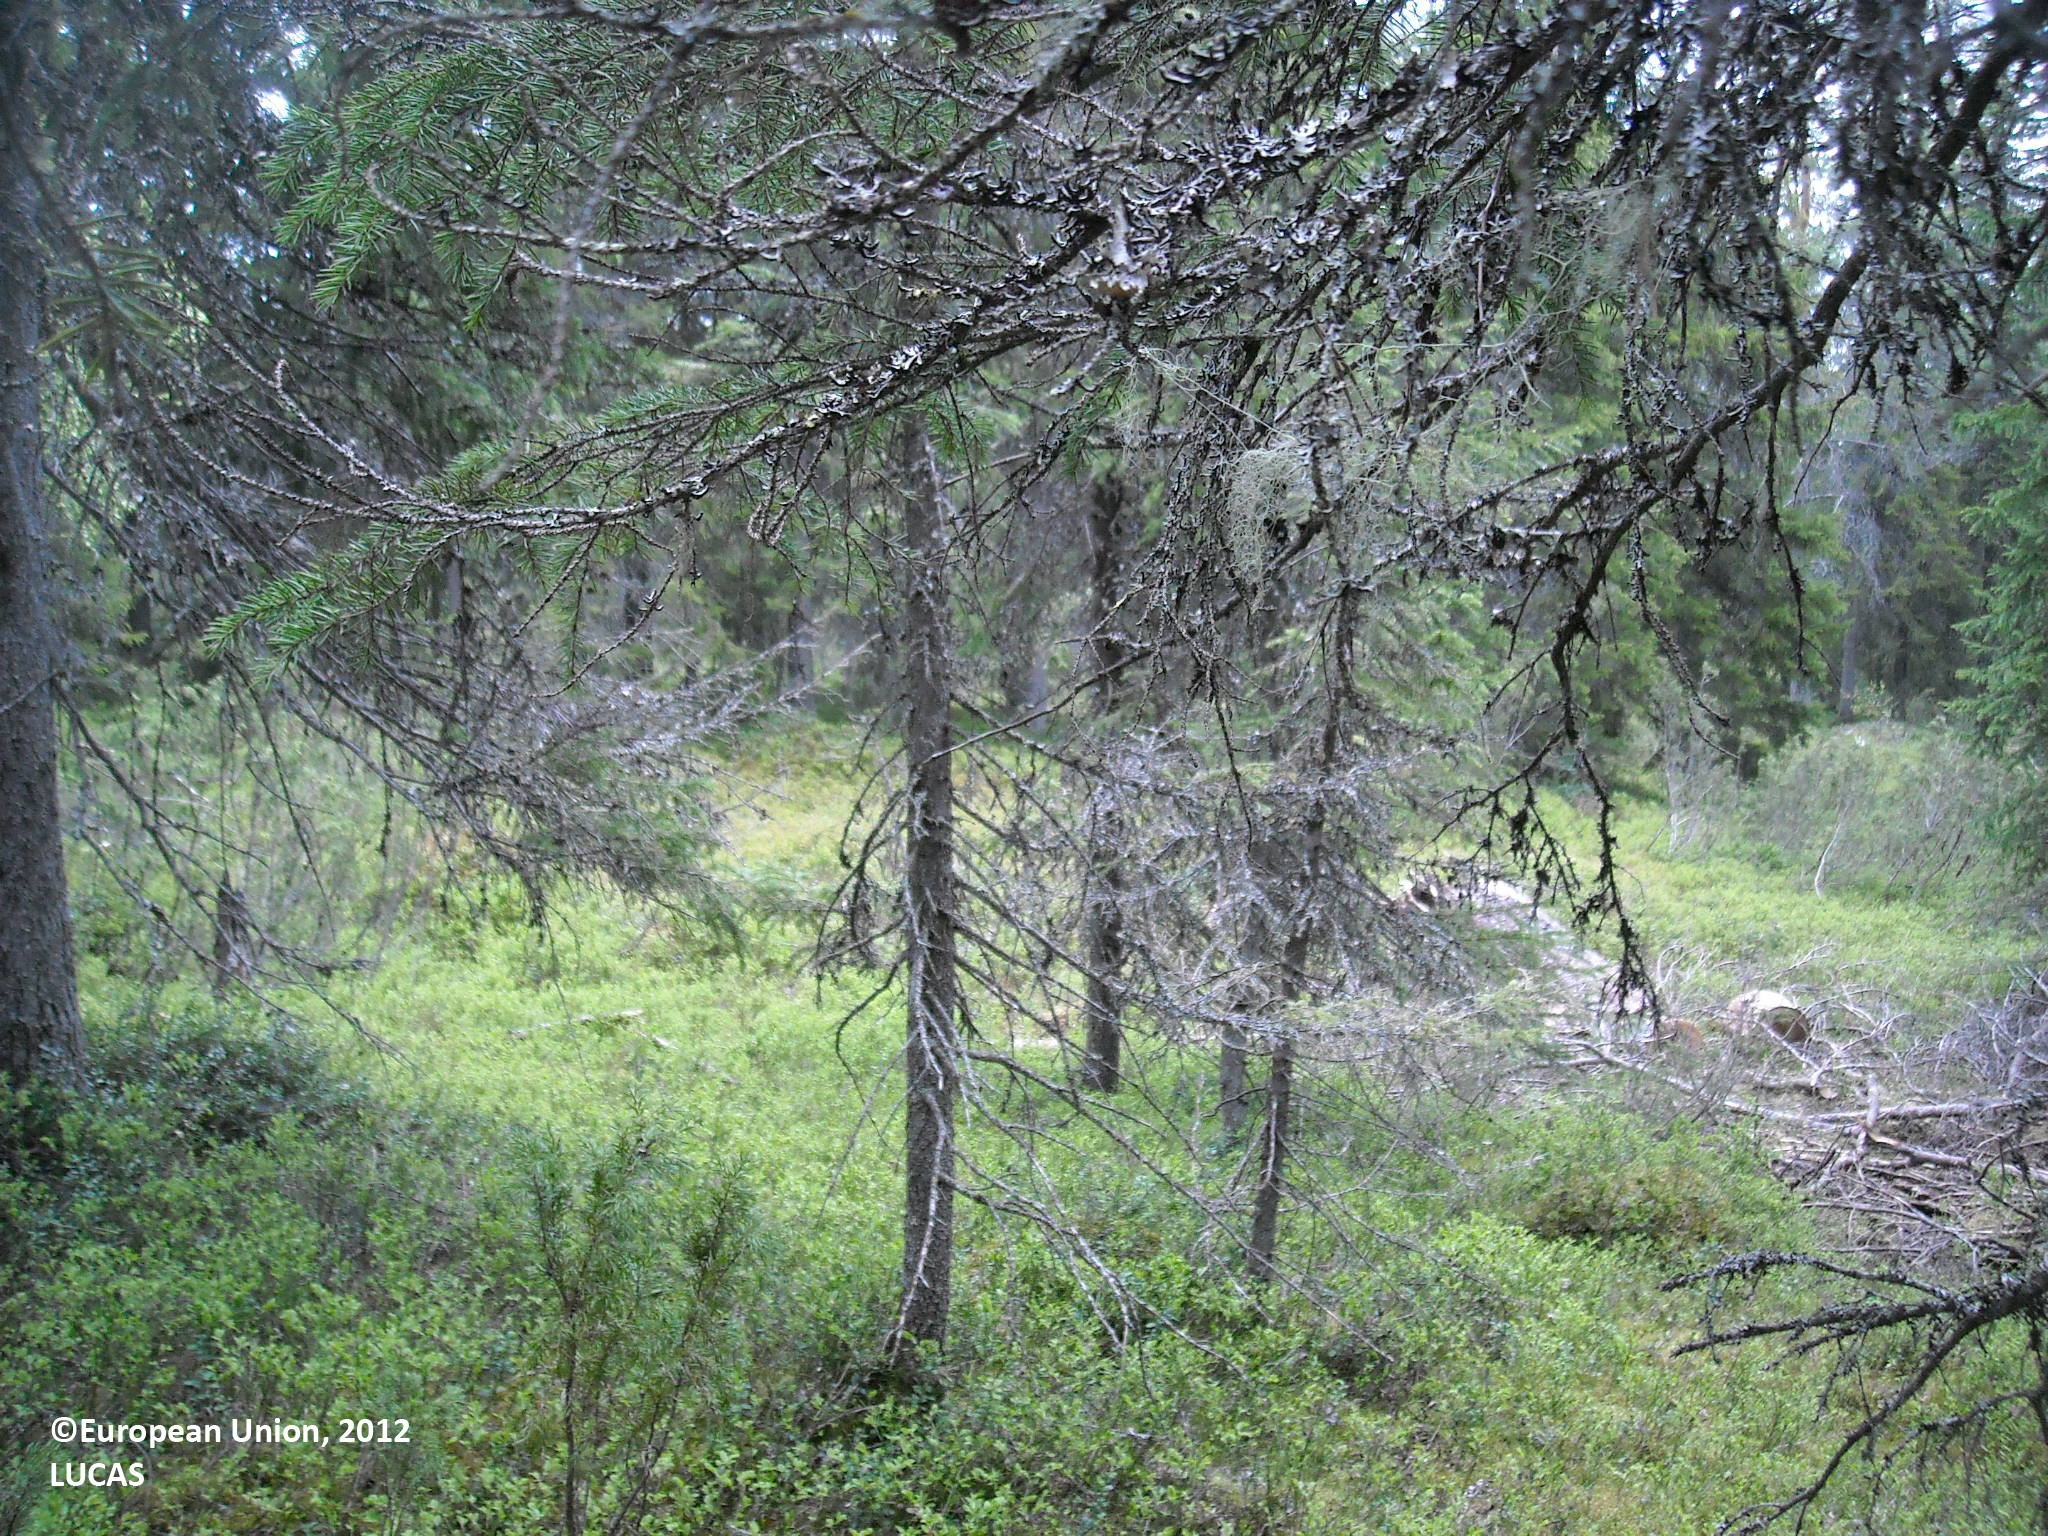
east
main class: Woodland
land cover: Spruce dominated coniferous woodland
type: boreal forest
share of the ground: > 75 %
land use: Forestry
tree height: > 5 m
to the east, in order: Spruce dominated coniferous woodland; Other coniferous woodland; Spruce dominated coniferous woodland; Spruce dominated mixed woodland; Other mixed woodland; Shrubland without tree cover; Ditches and canals; Shrubland without tree cover
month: June
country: FI
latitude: 65.3166
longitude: 27.8036
